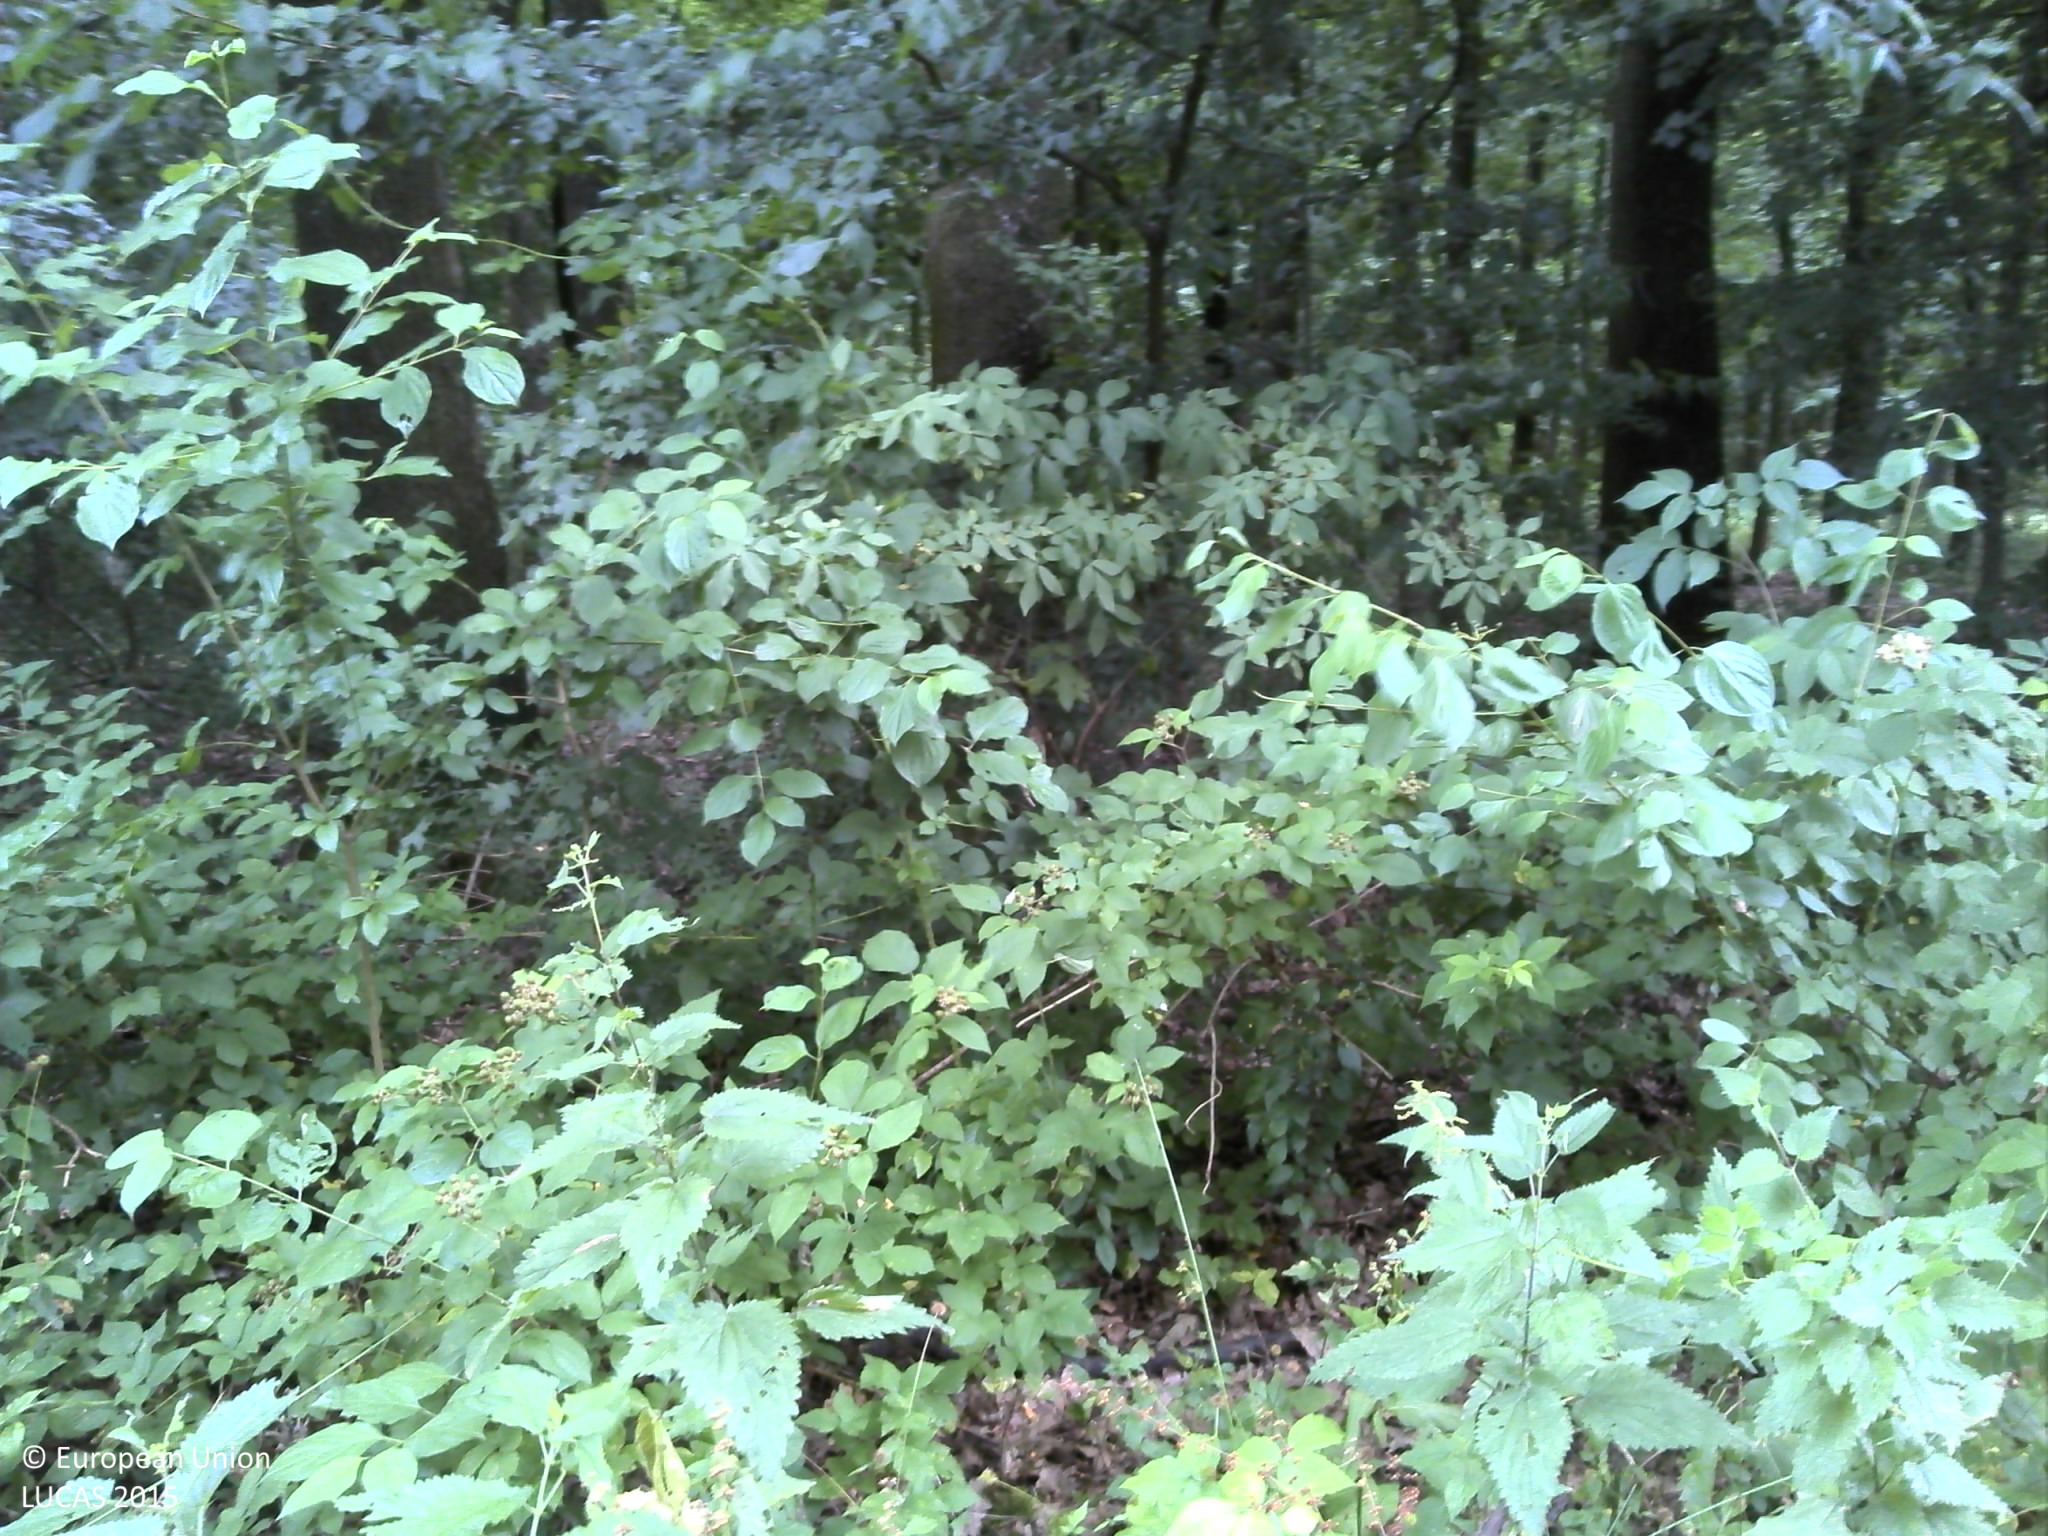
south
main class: Woodland
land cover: Broadleaved woodland
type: acidophilous oak and oak-birch forest
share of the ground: > 75 %
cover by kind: broadleaved forest trees 100 %
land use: Forestry
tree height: > 5 m
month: June
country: HR
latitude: 45.4186
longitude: 18.4528
